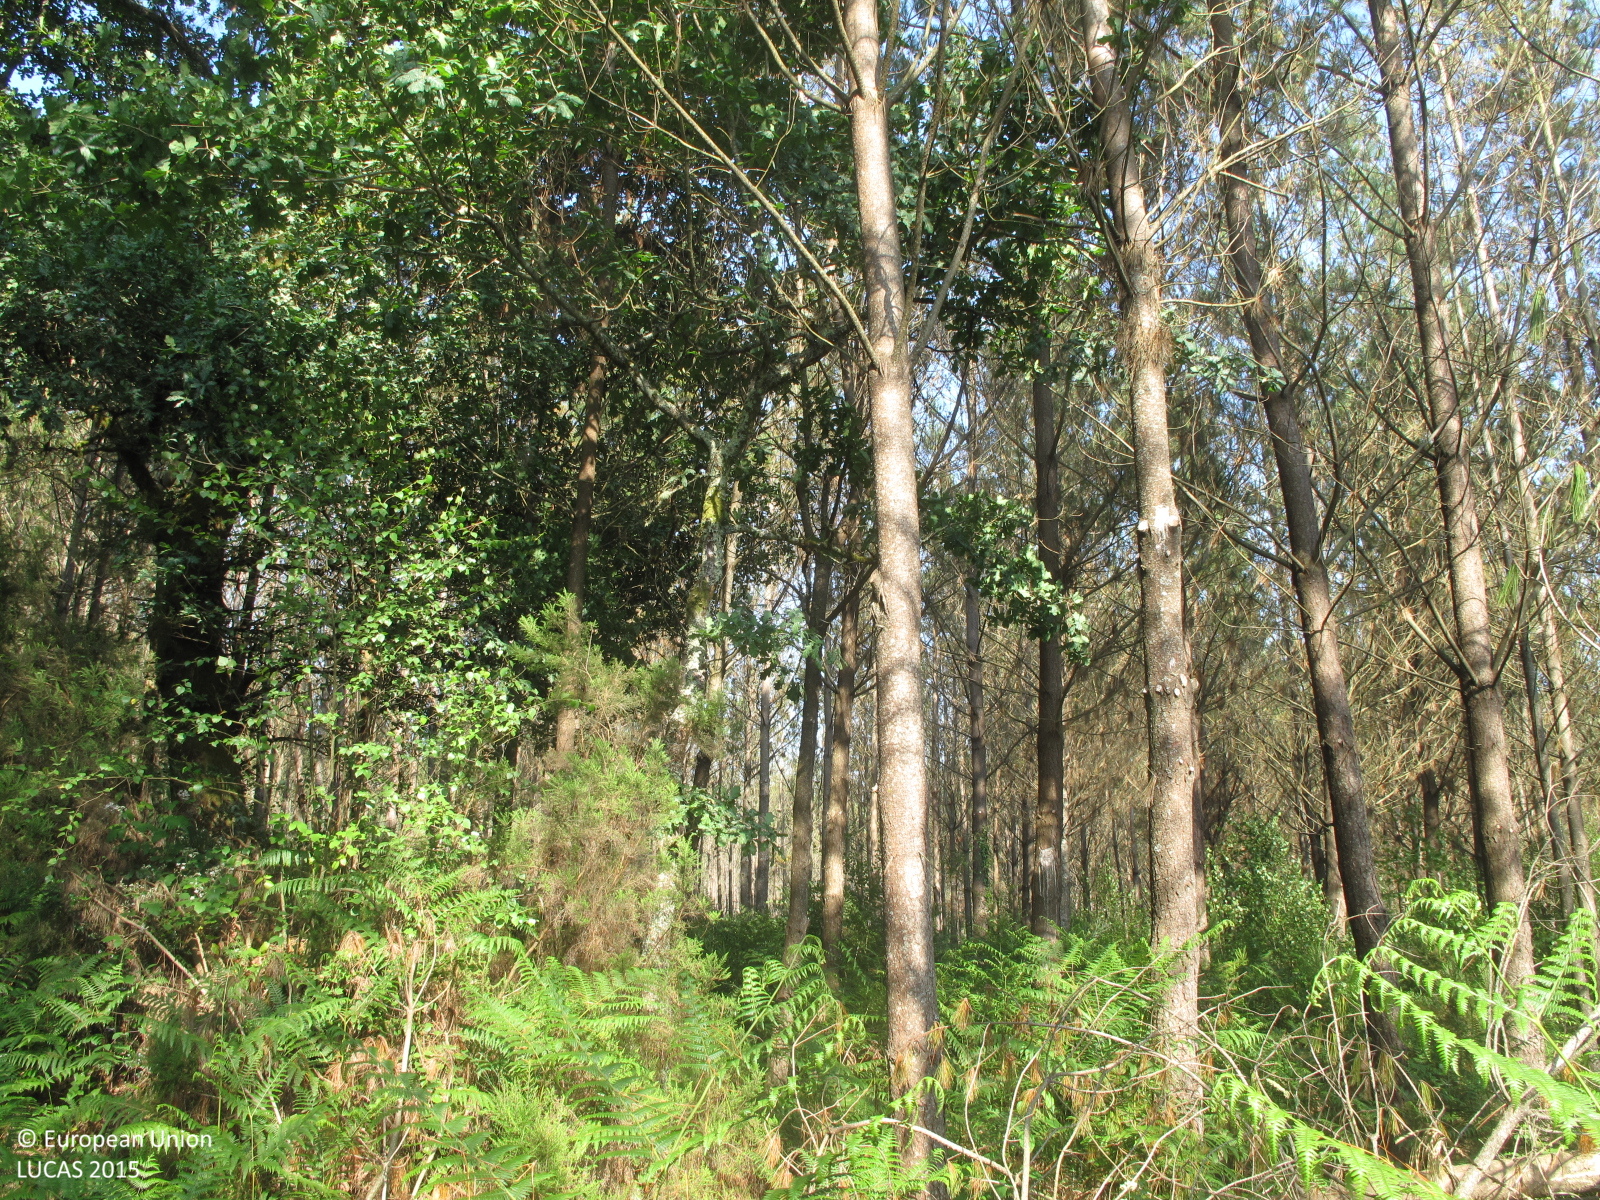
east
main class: Woodland
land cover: Pine dominated coniferous woodland
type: exotic forest
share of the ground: 50 - 75 %
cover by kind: coniferous forest trees 60 %, shrubs 20 %, broadleaved forest trees 10 %, herbaceous plants 10 %
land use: Forestry
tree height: > 5 m
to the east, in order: Pine dominated coniferous woodland; Fences; Tracks; Broadleaved woodland; Rivers and streams; Broadleaved woodland; Spontaneously vegetated surfaces
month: June
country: ES
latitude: 43.0197
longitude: -7.8916
